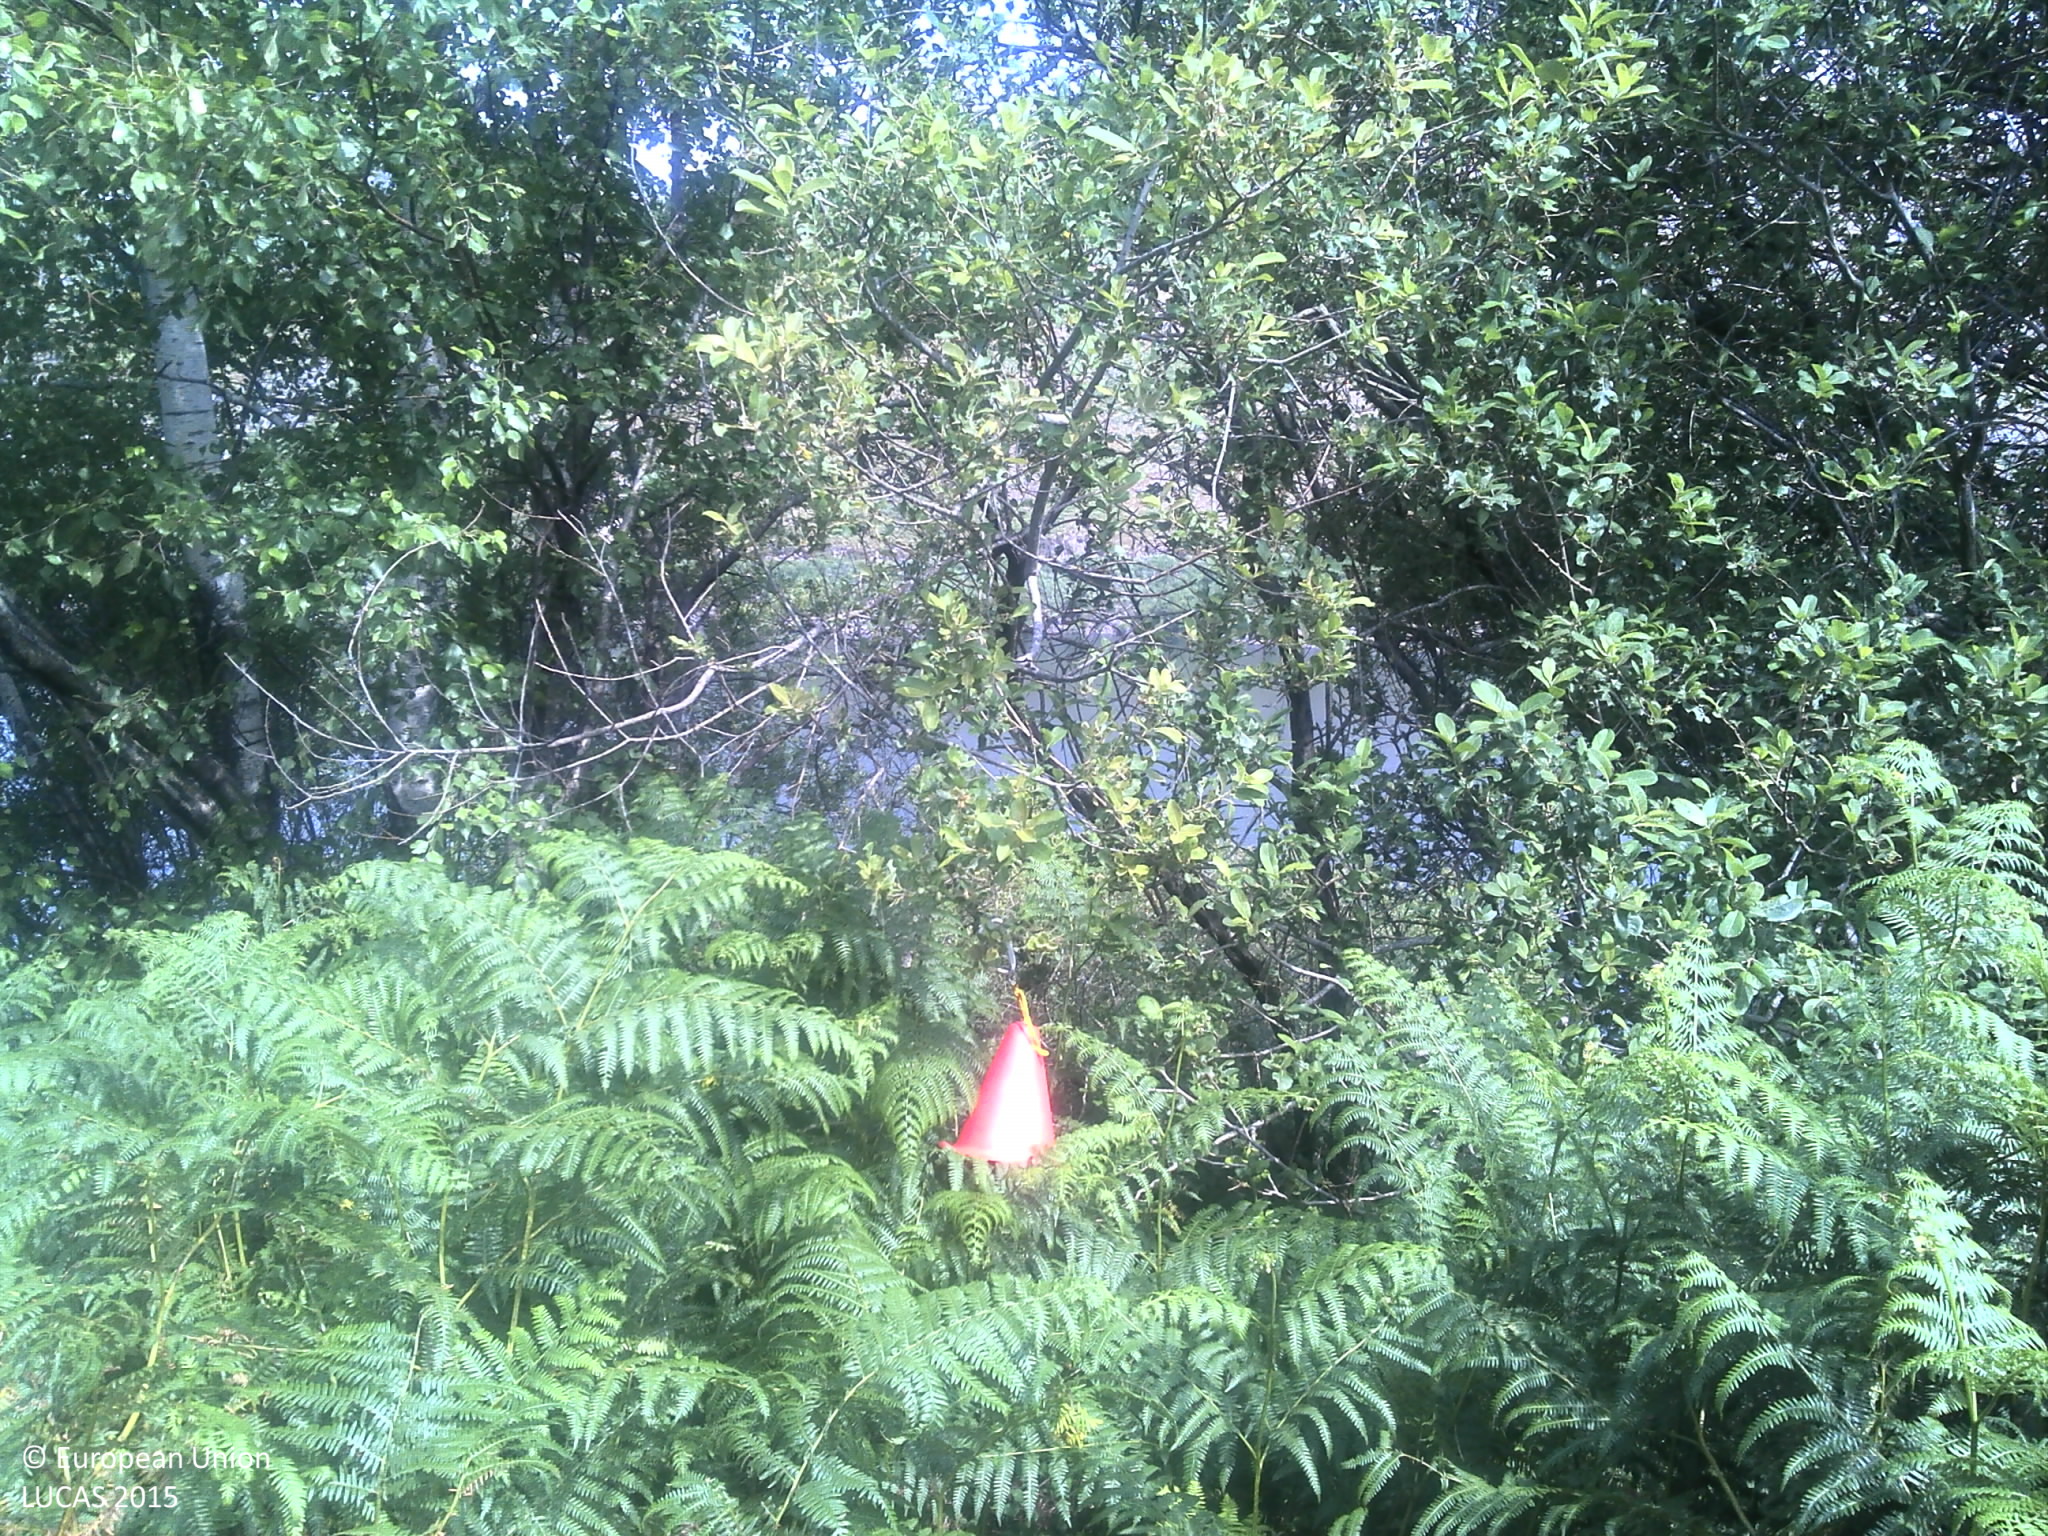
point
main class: Woodland
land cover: Broadleaved woodland
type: thermophilous deciduous forest
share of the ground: 50 - 75 %
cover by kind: broadleaved forest trees 65 %, shrubs 25 %, herbaceous plants 5 %, unconsolidated bare surface 5 %
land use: Semi-natural and natural areas not in use
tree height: > 5 m
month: June
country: PT
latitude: 41.7632
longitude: -8.2053
